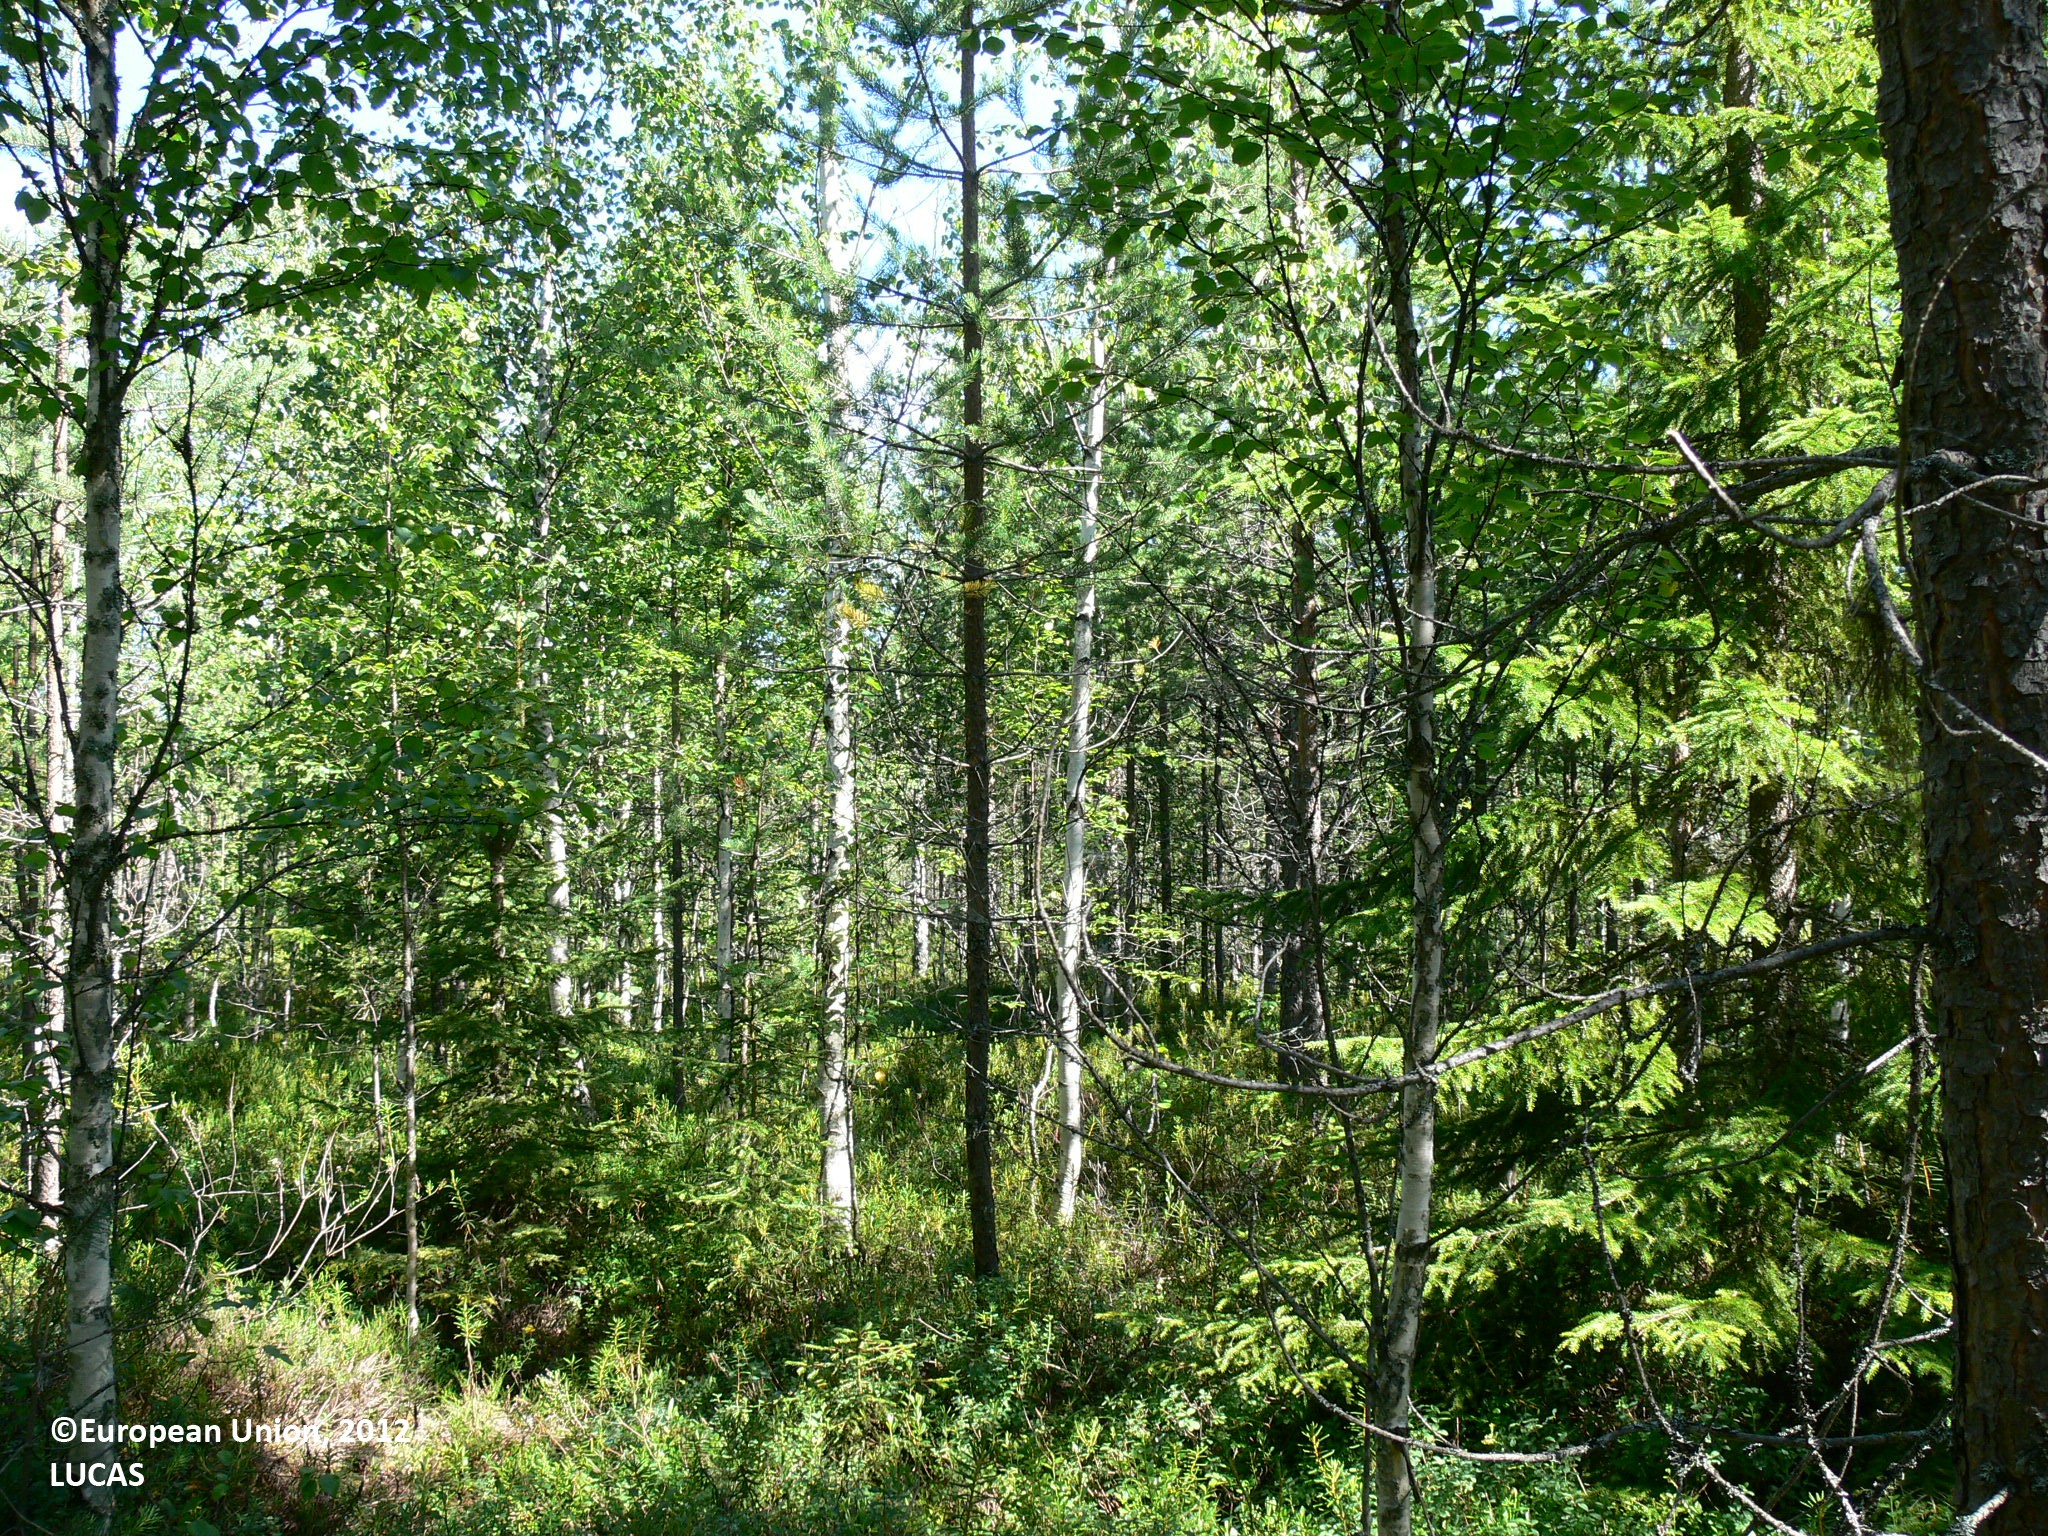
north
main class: Woodland
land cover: Other mixed woodland
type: boreal forest
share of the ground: 50 - 75 %
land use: Forestry
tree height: > 5 m
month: July
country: FI
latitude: 63.0676
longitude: 29.4048
